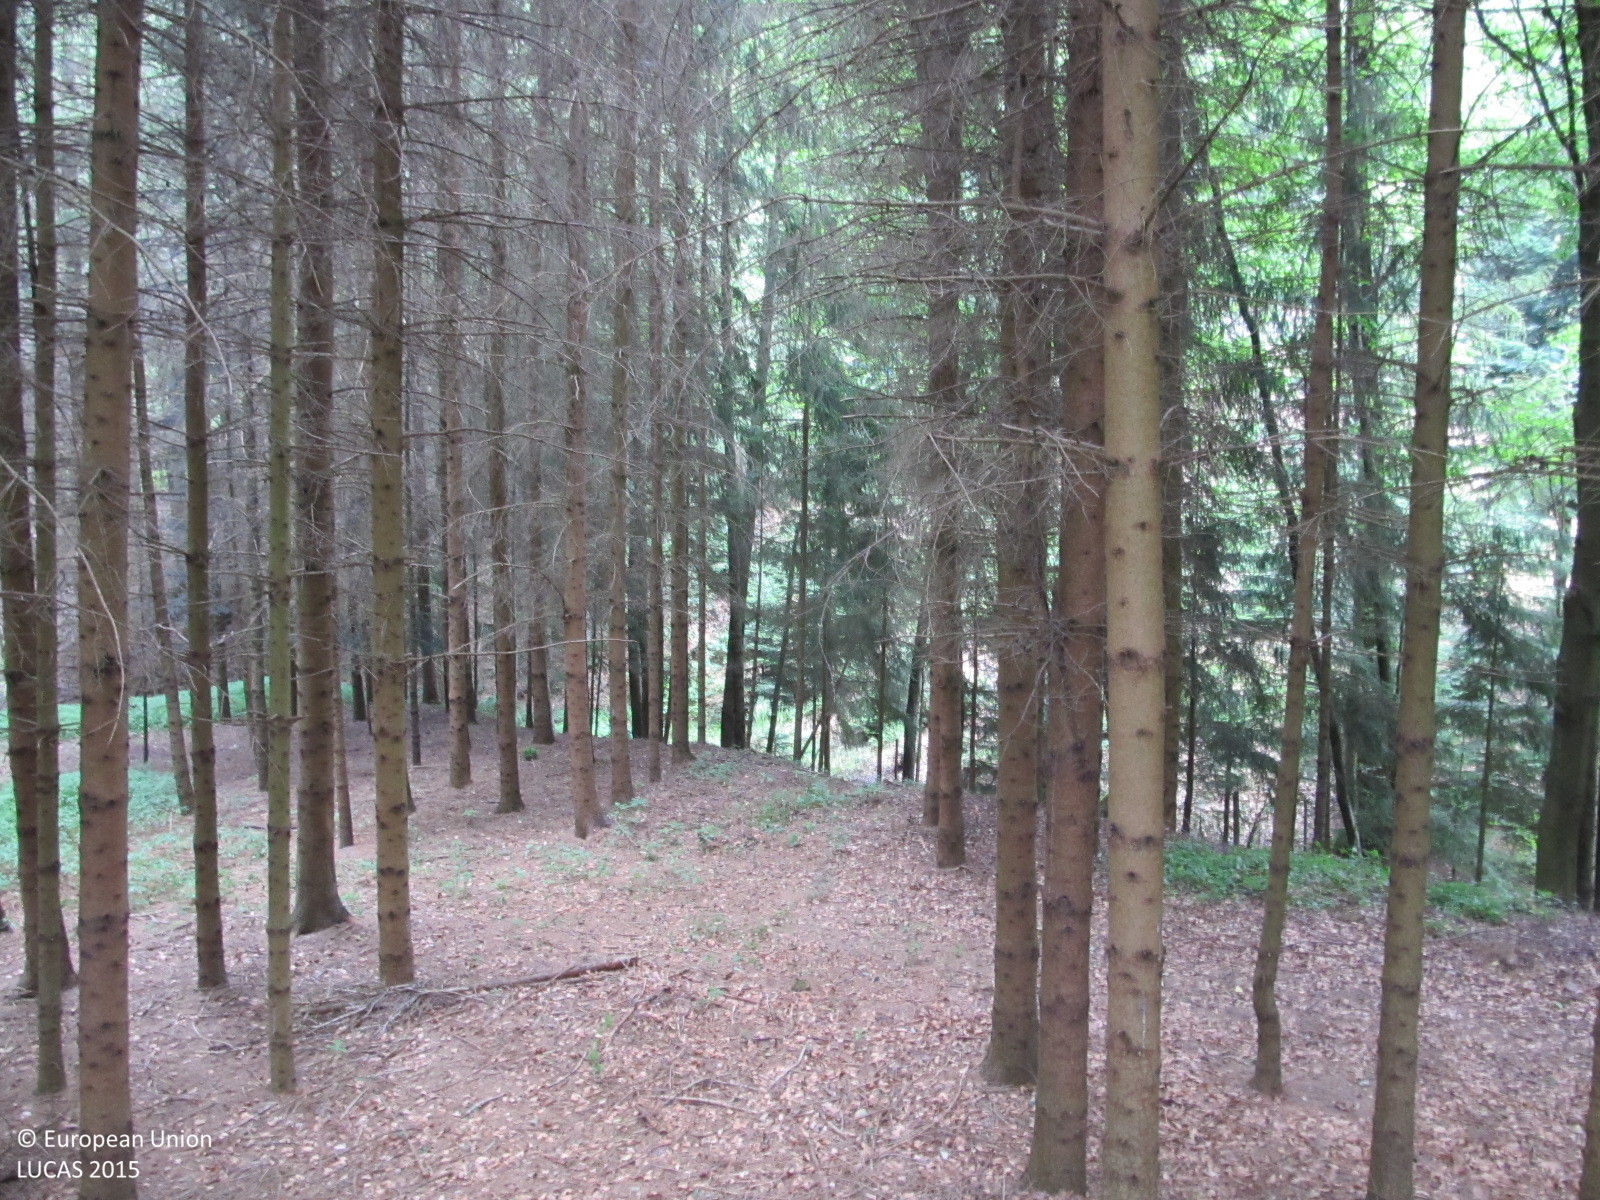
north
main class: Woodland
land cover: Spruce dominated coniferous woodland
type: hemiboreal forest and nemoral coniferous forest and mixed broadleaved-coniferous forest
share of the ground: > 75 %
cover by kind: coniferous forest trees 80 %, unconsolidated bare surface 20 %
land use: Forestry
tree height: > 5 m
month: July
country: AT
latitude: 48.2687
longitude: 15.4587
